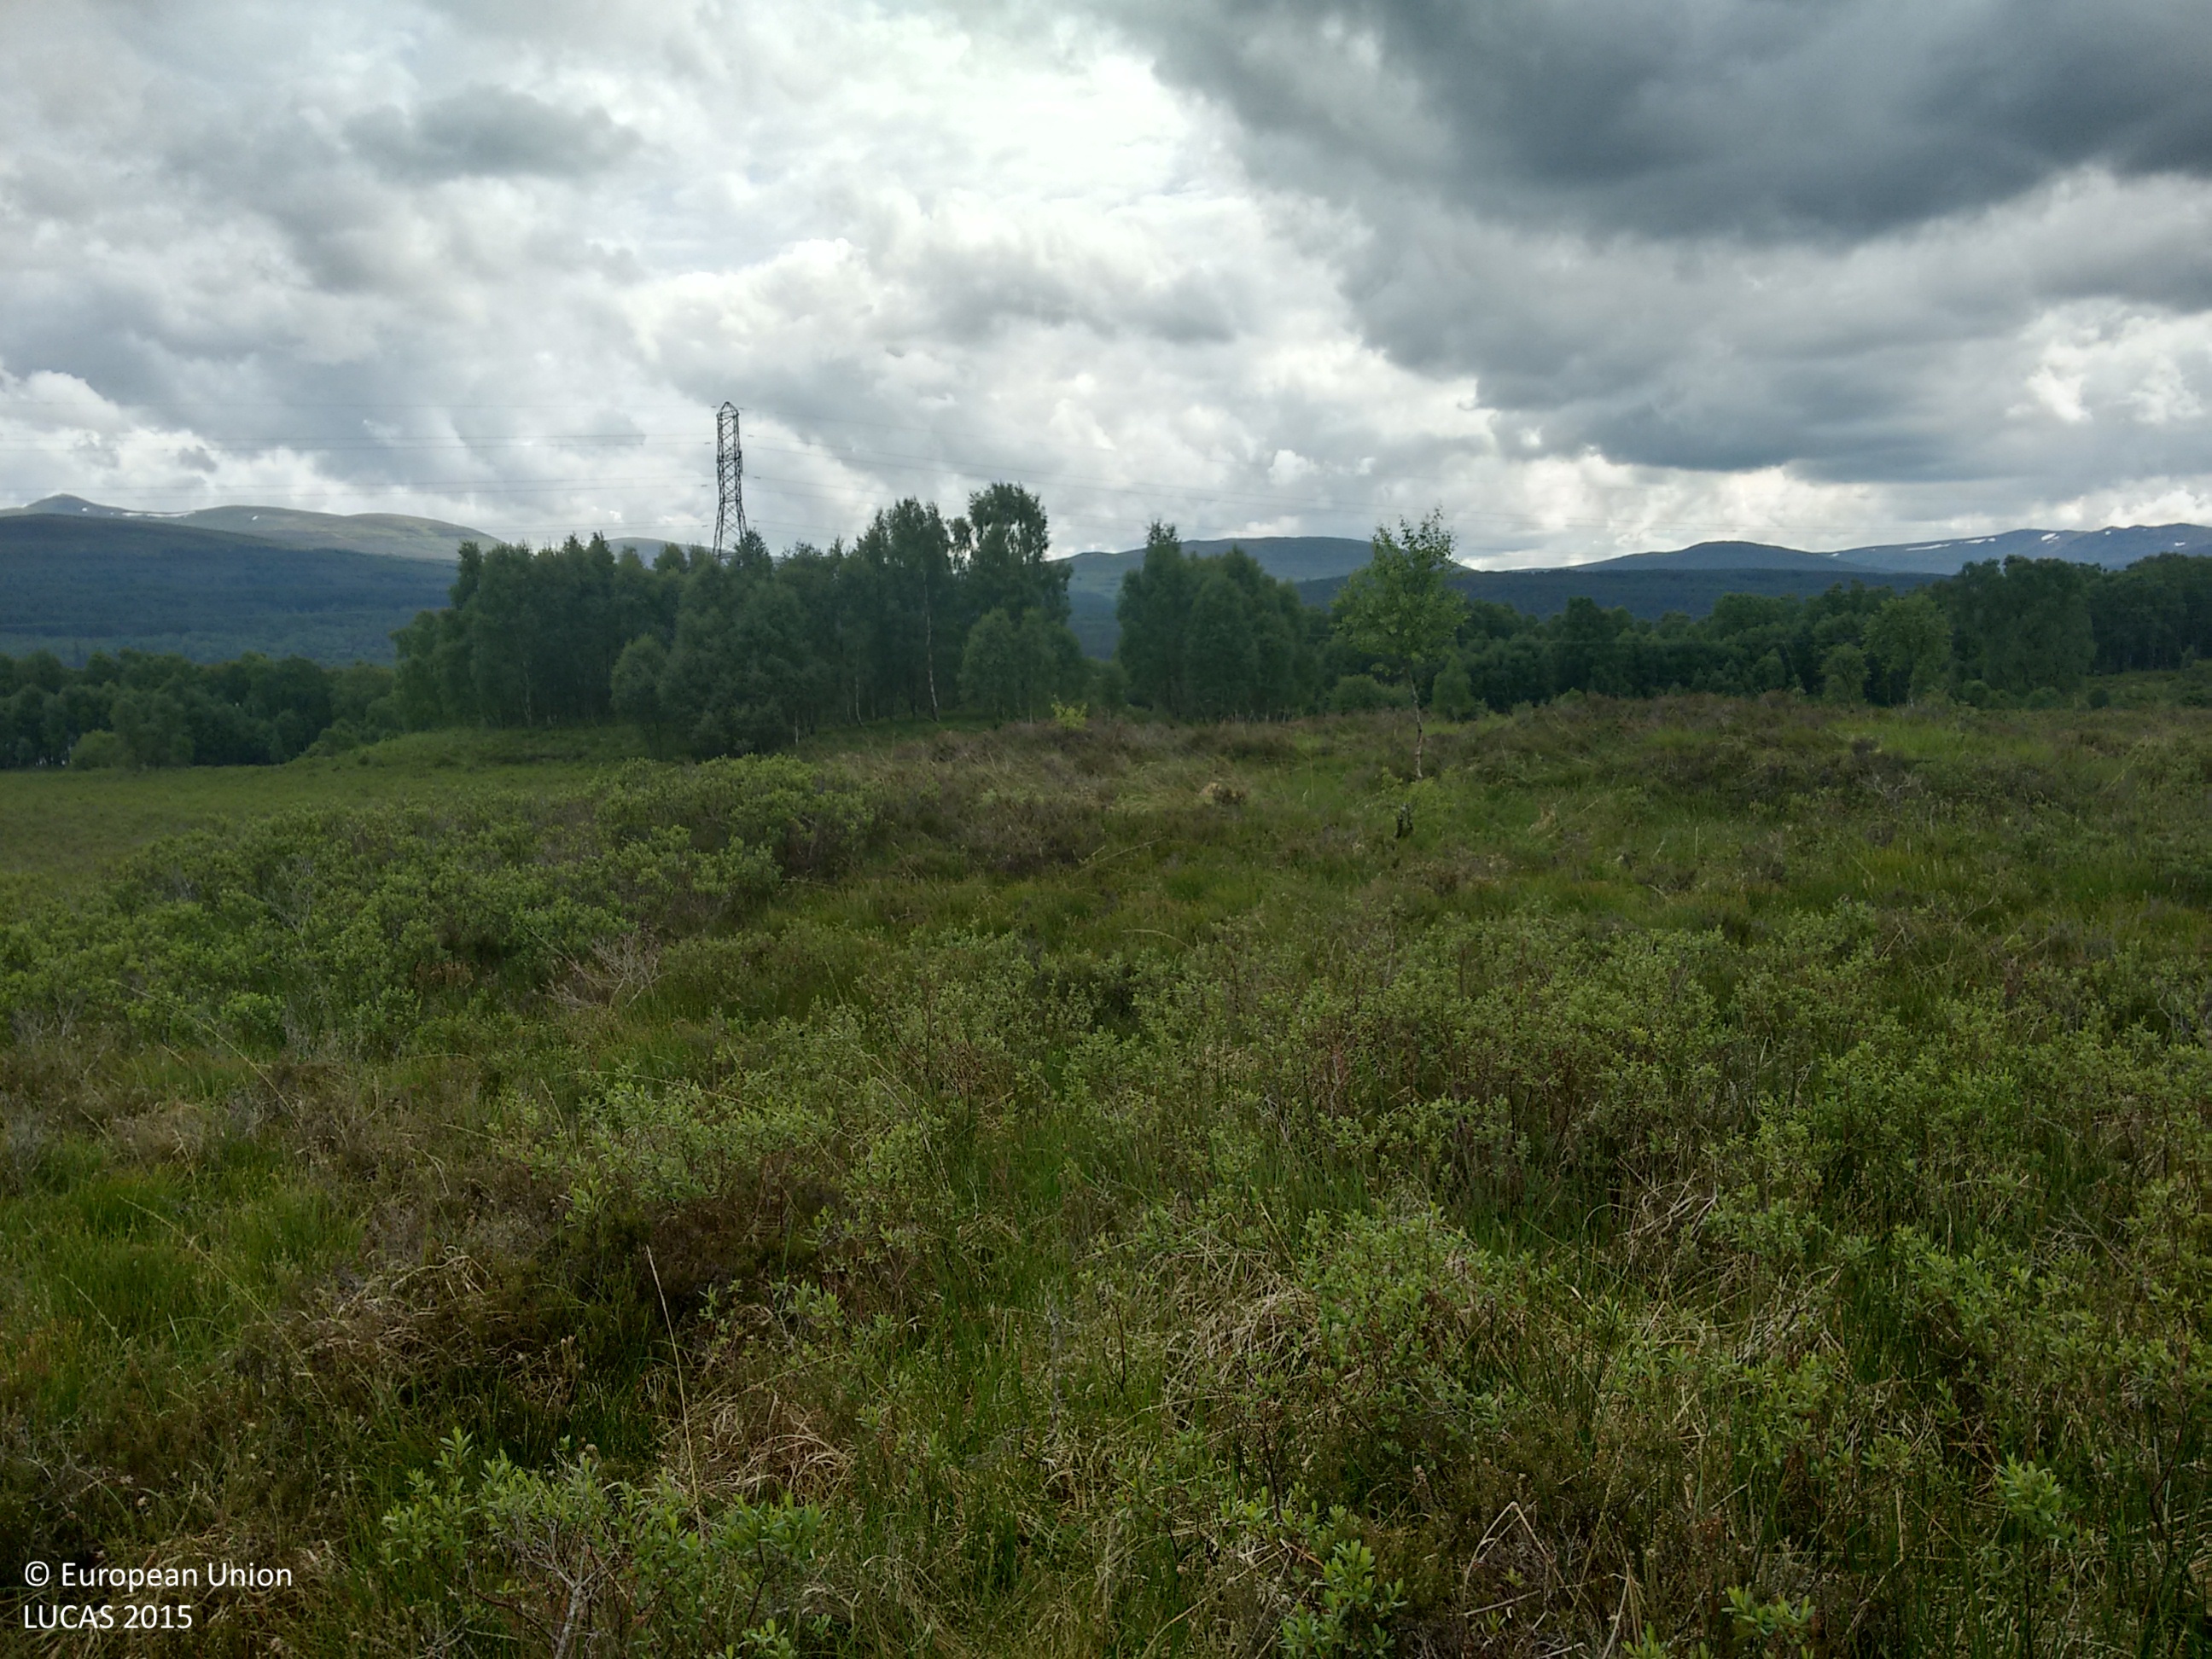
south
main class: Shrubland
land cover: Shrubland without tree cover
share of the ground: > 75 %
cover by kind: shrubs 65 %, herbaceous plants 25 %, lichens and mosses 10 %
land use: Semi-natural and natural areas not in use
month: July
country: GB
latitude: 56.6969
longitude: -4.3145
